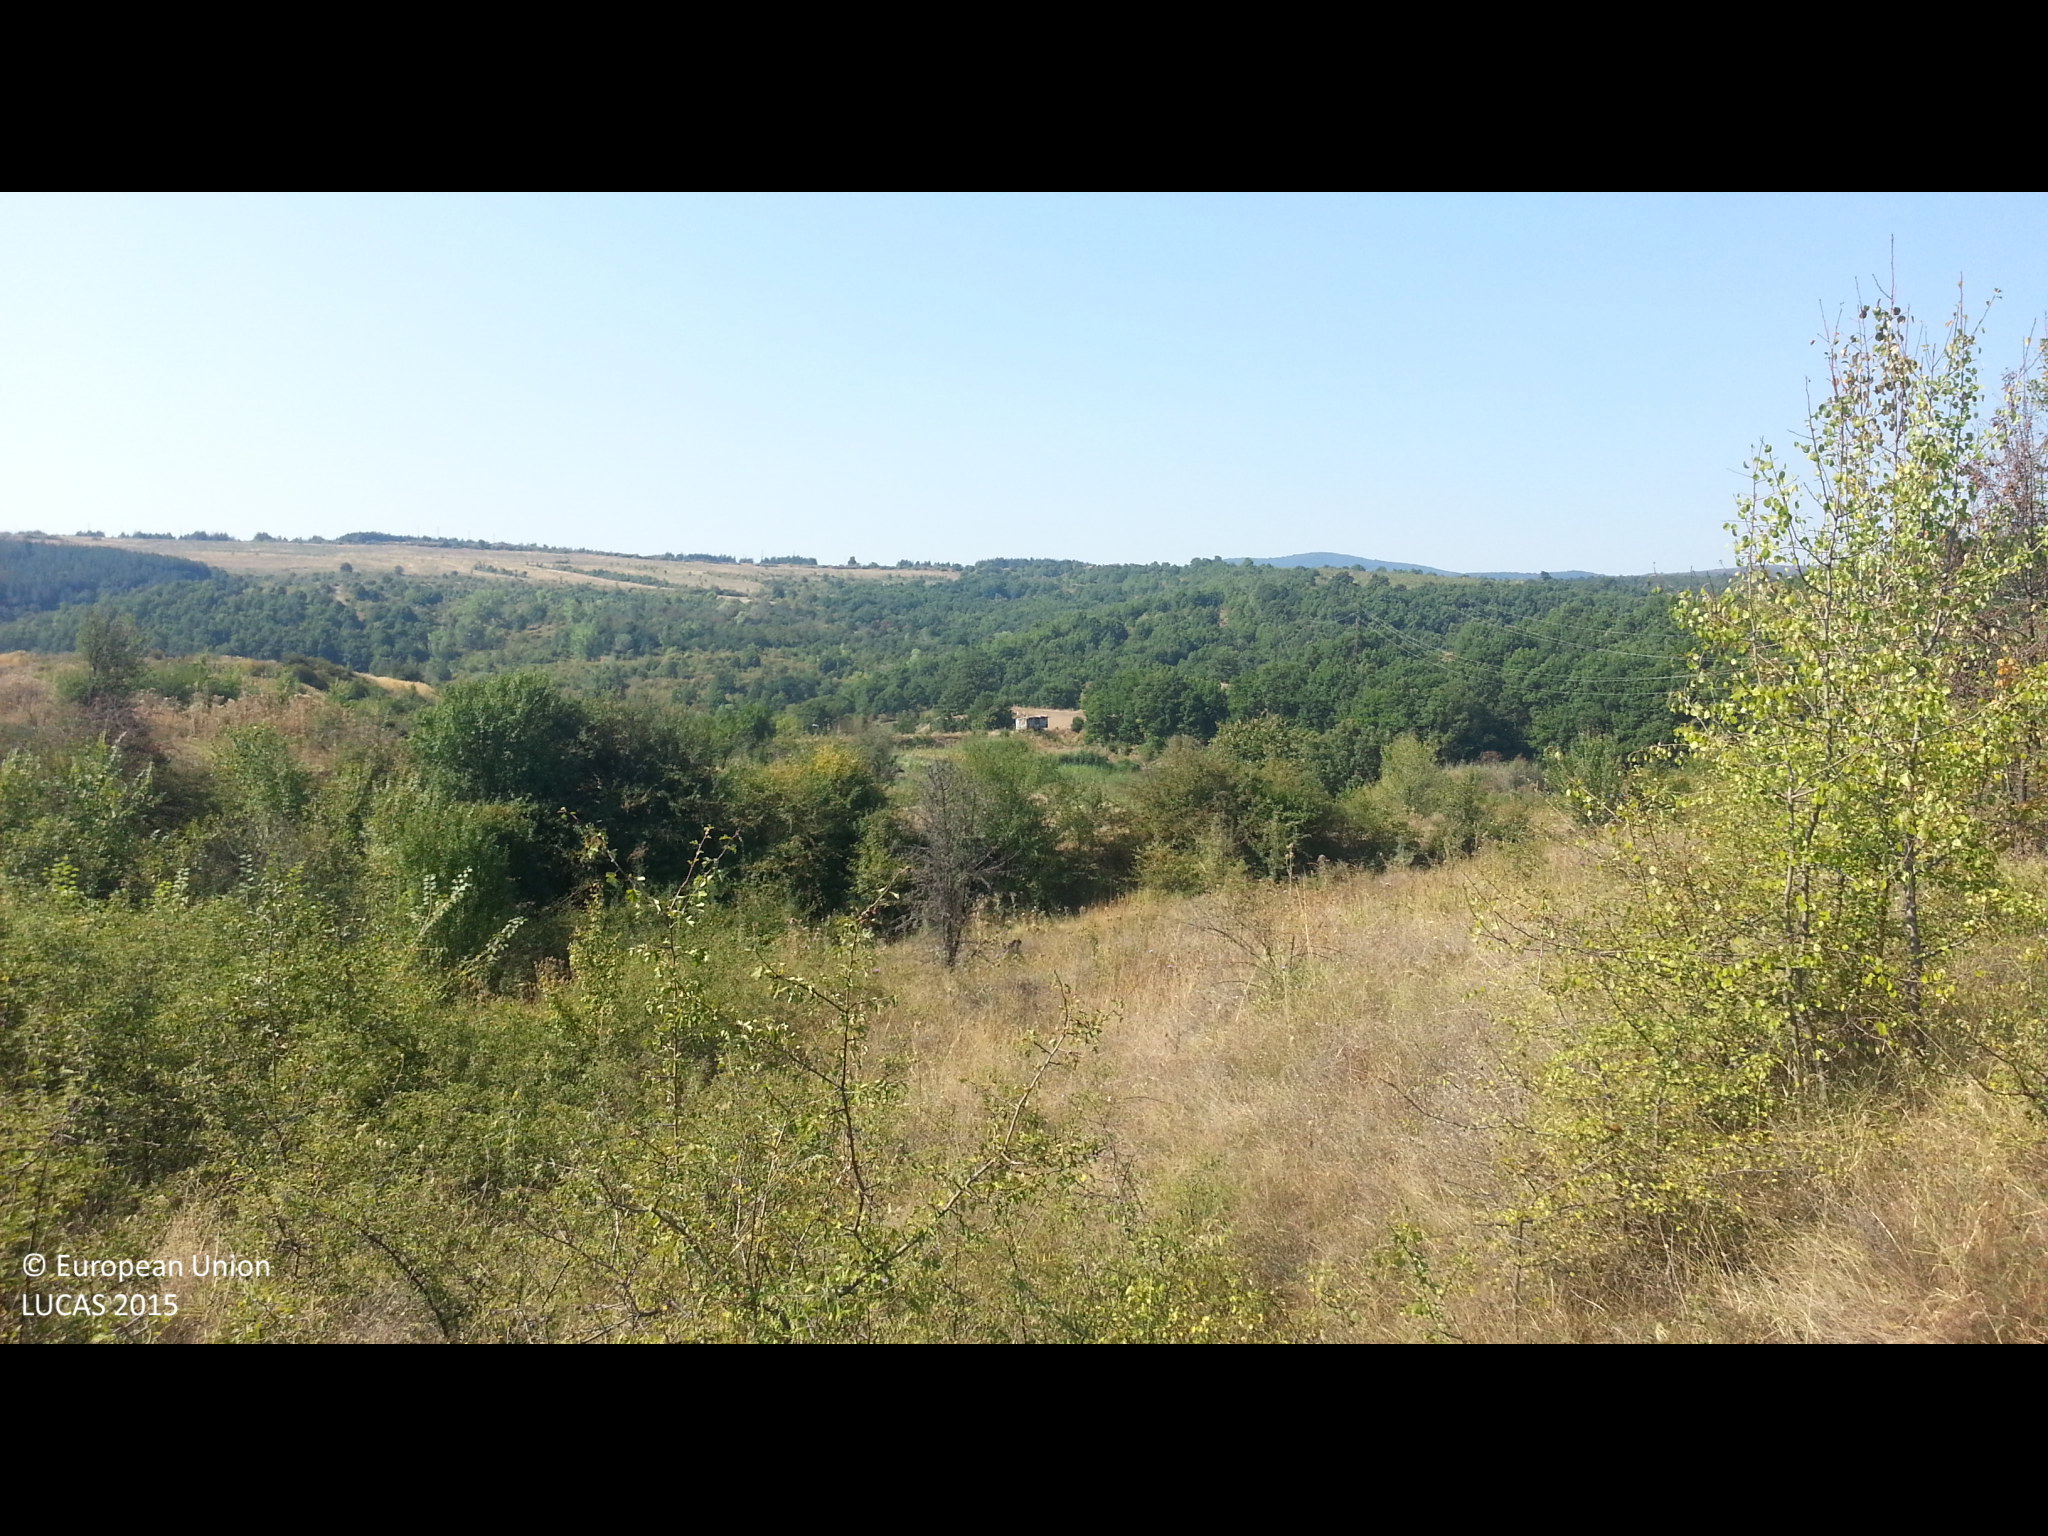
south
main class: Grassland
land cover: Grassland with sparse tree/shrub cover
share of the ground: > 75 %
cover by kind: herbaceous plants 95 %, broadleaved forest trees 5 %
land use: Semi-natural and natural areas not in use
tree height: < 5 m
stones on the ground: < 10 %
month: September
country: BG
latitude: 42.3805
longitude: 22.9856
